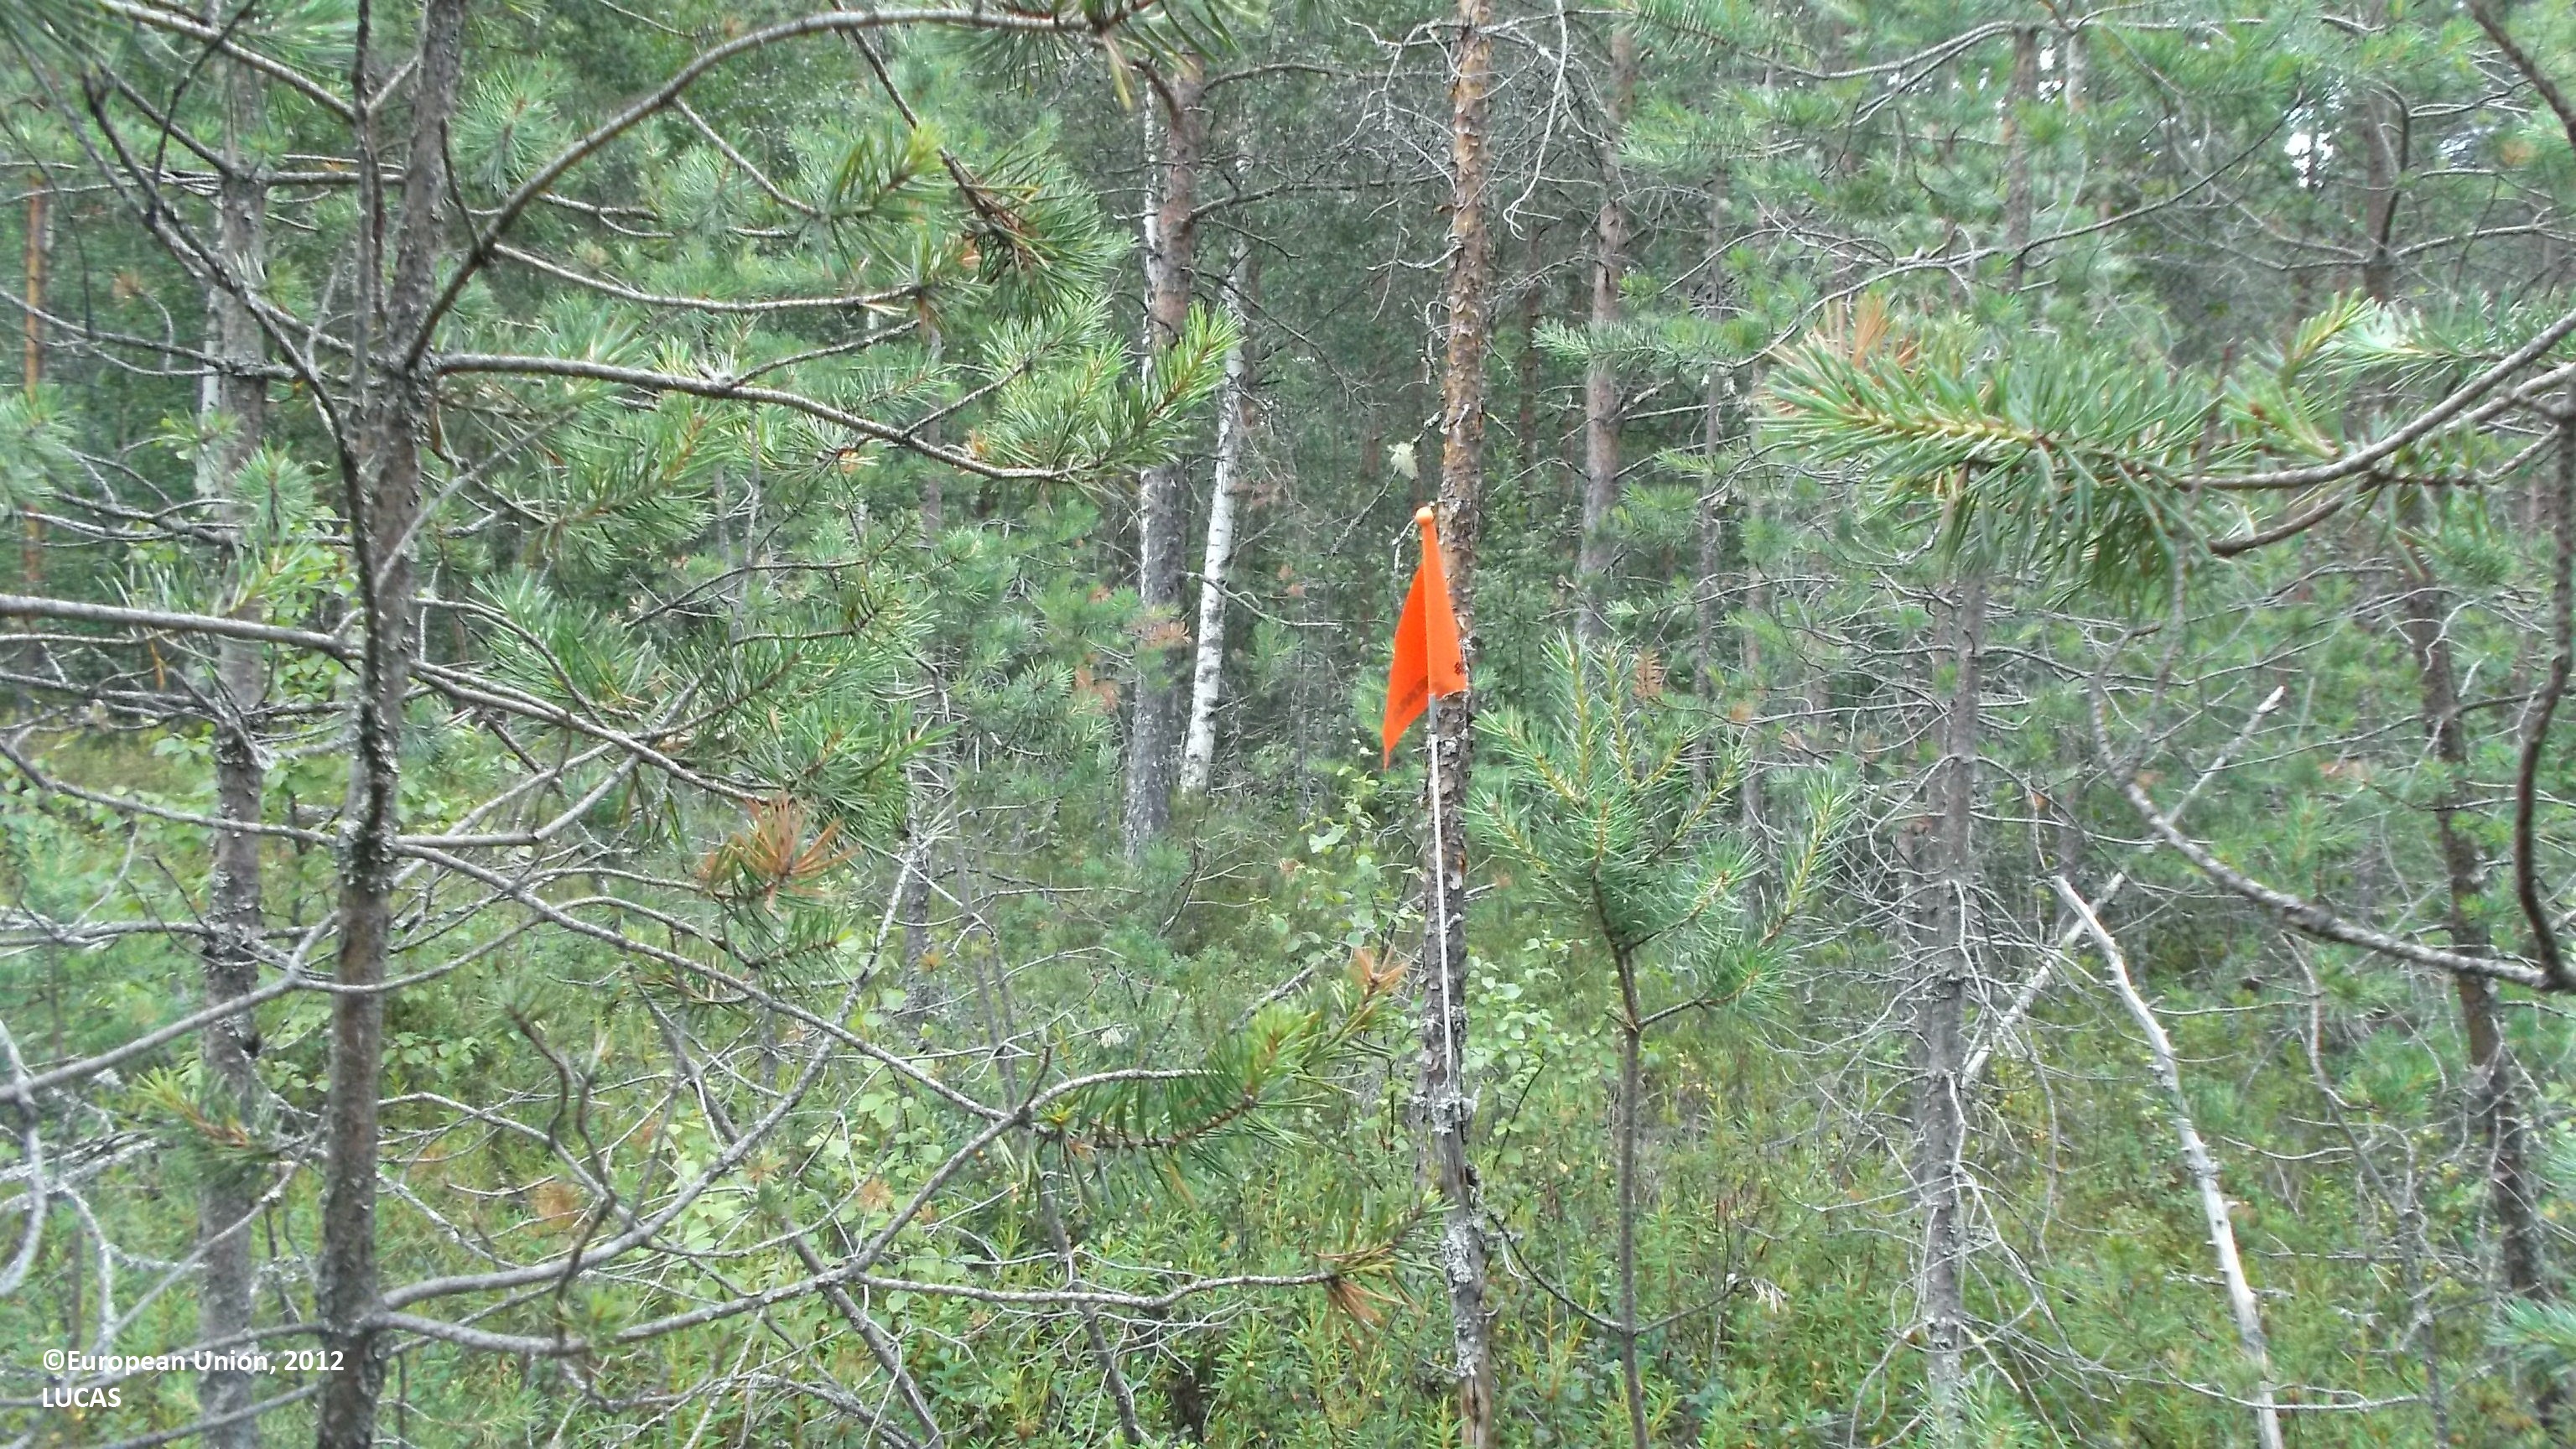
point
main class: Woodland
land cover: Pine dominated coniferous woodland
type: mire and swamp forests
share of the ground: 25 - 50 %
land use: Forestry
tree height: < 5 m
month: July
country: FI
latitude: 63.5470
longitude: 23.2365
